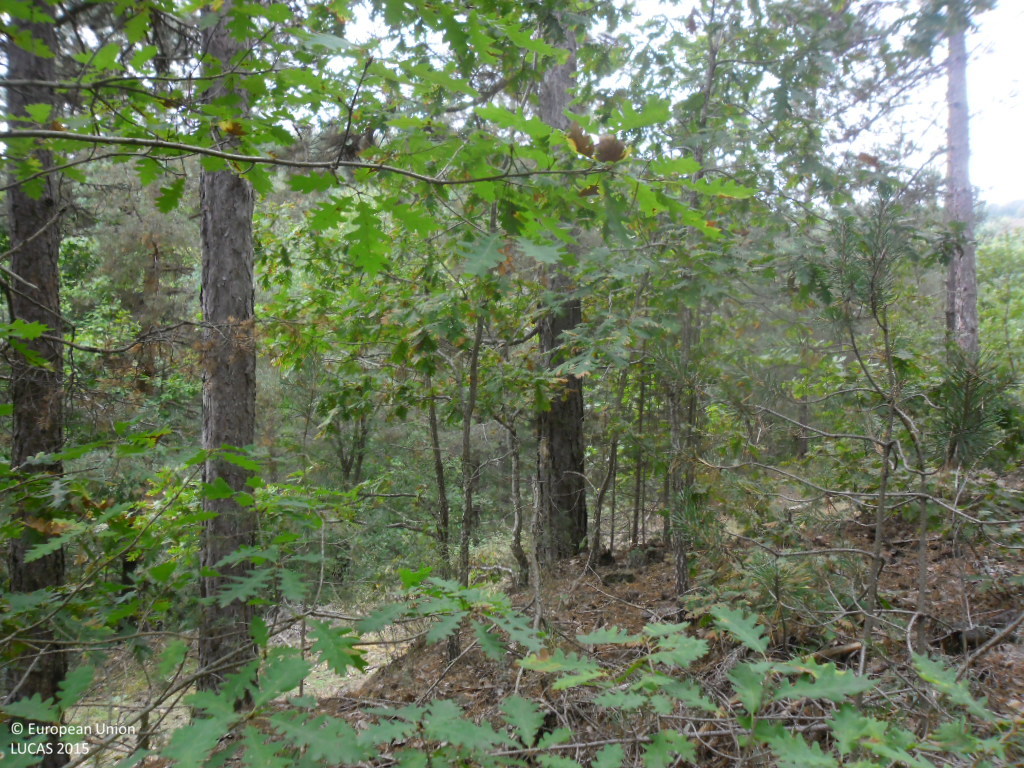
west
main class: Woodland
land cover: Pine dominated coniferous woodland
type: hemiboreal forest and nemoral coniferous forest and mixed broadleaved-coniferous forest
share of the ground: > 75 %
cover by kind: coniferous forest trees 95 %, unconsolidated bare surface 5 %
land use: Forestry
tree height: > 5 m
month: September
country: BG
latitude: 41.6418
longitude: 23.0458
